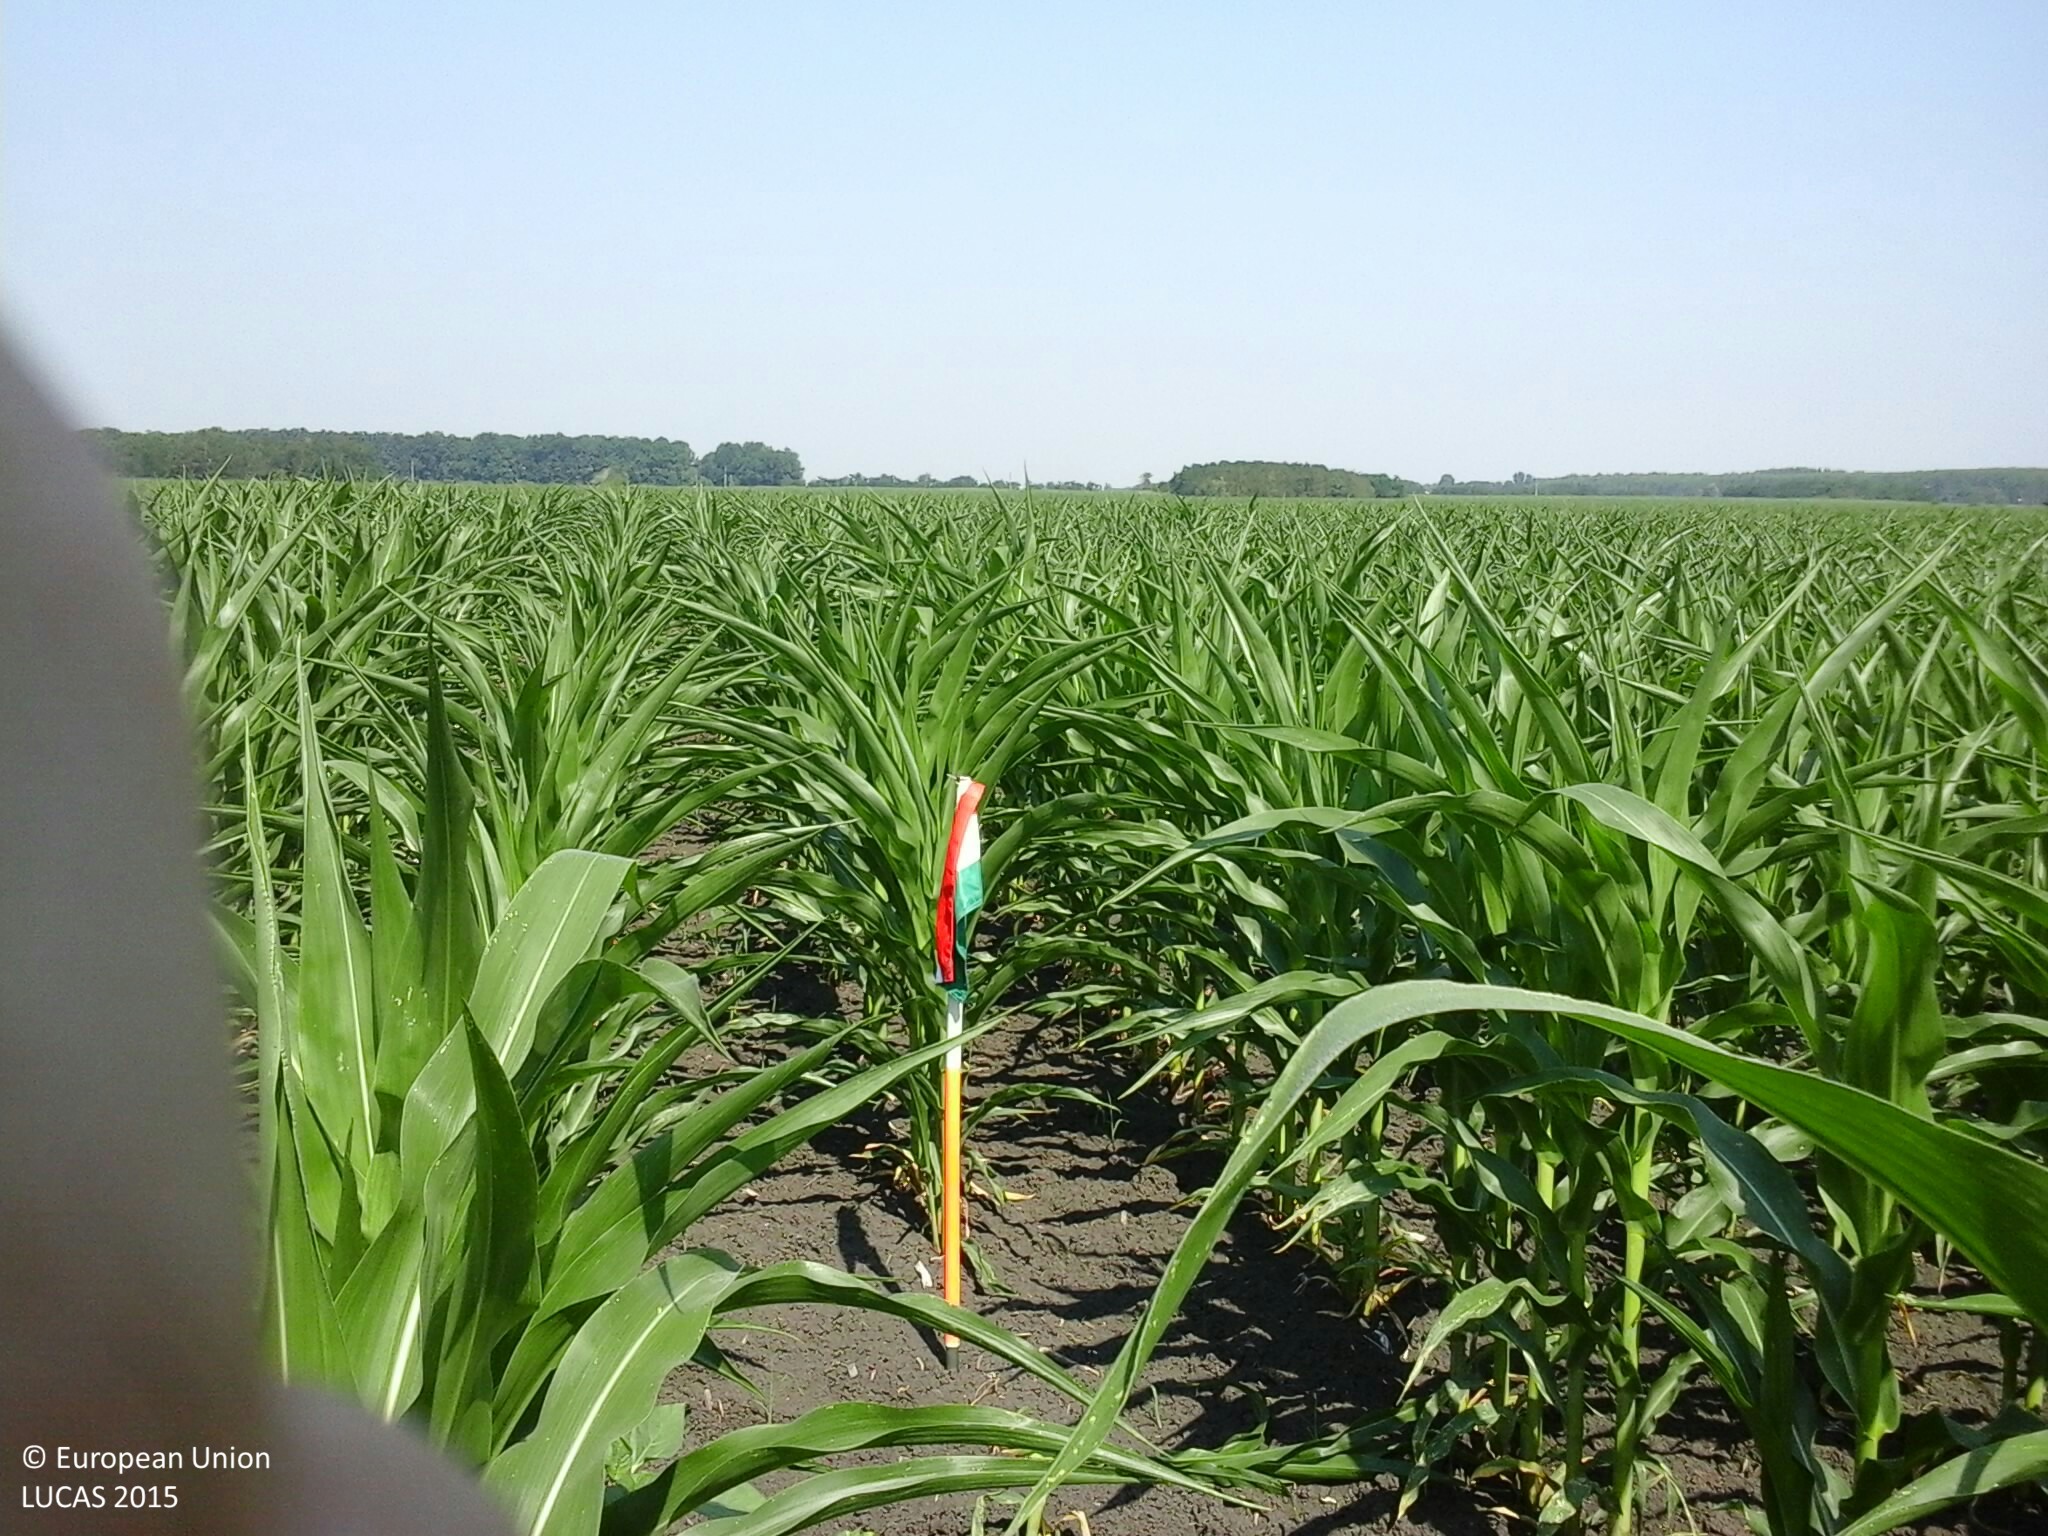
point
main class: Cropland
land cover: Maize
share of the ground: > 75 %
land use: Agriculture (excluding fallow land and kitchen gardens)
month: July
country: HU
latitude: 46.7722
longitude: 20.1737
